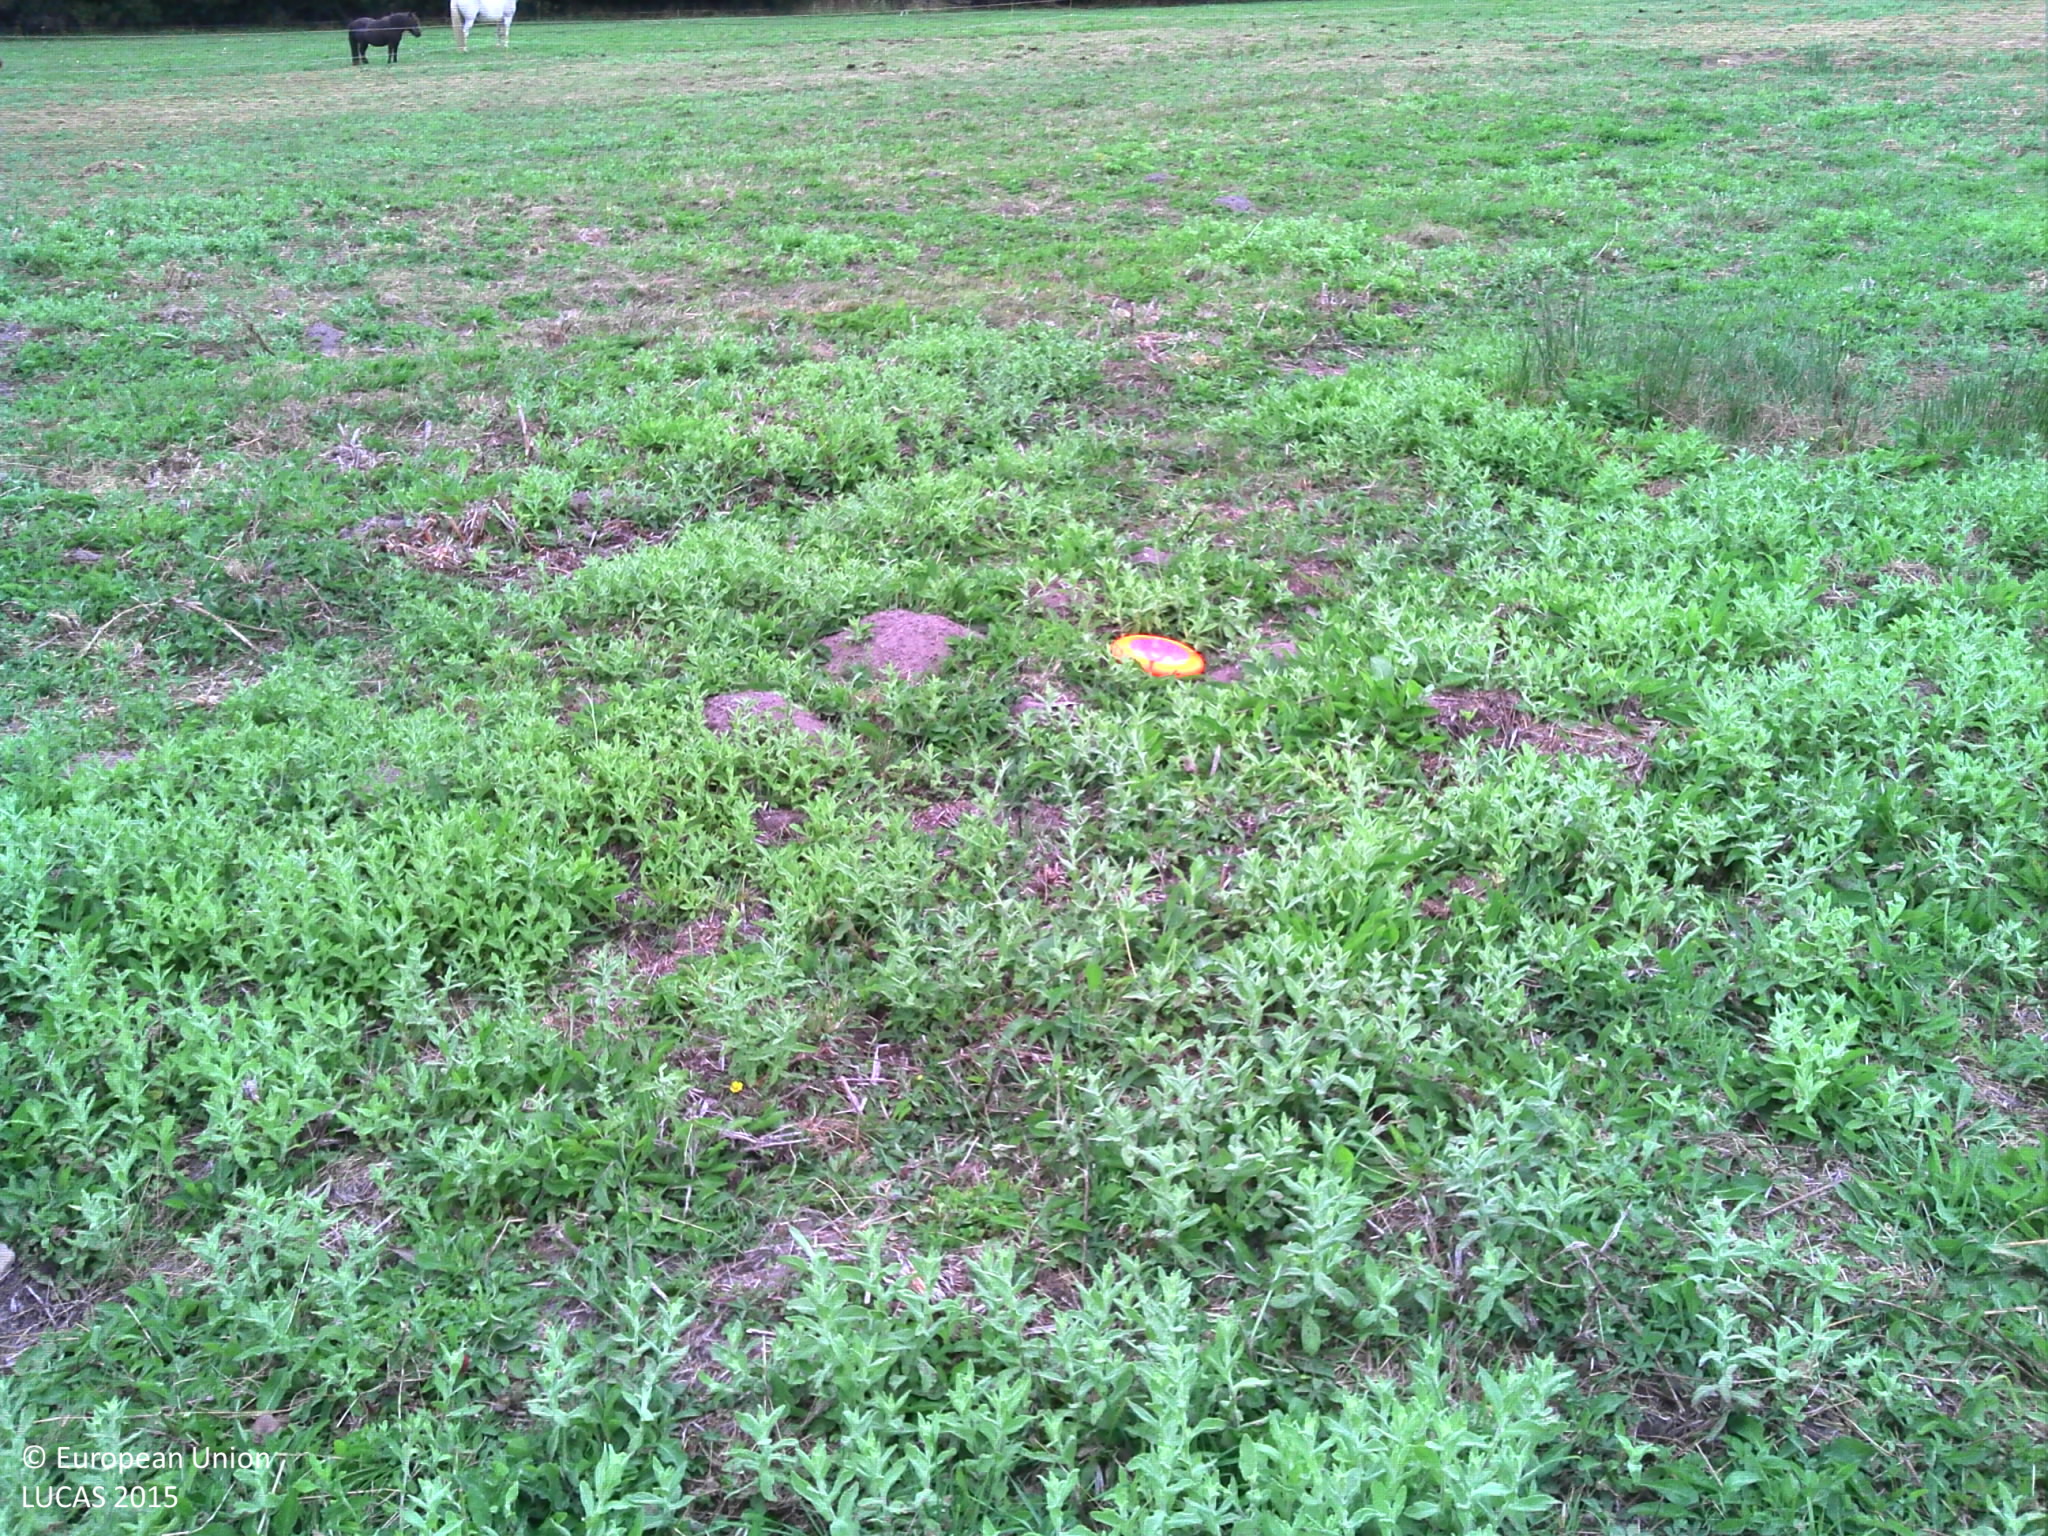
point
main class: Grassland
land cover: Spontaneously vegetated surfaces
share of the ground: > 75 %
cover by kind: herbaceous plants 90 %, unconsolidated bare surface 10 %
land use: Agriculture (excluding fallow land and kitchen gardens)
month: July
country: FR
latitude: 47.6787
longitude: -3.2170
